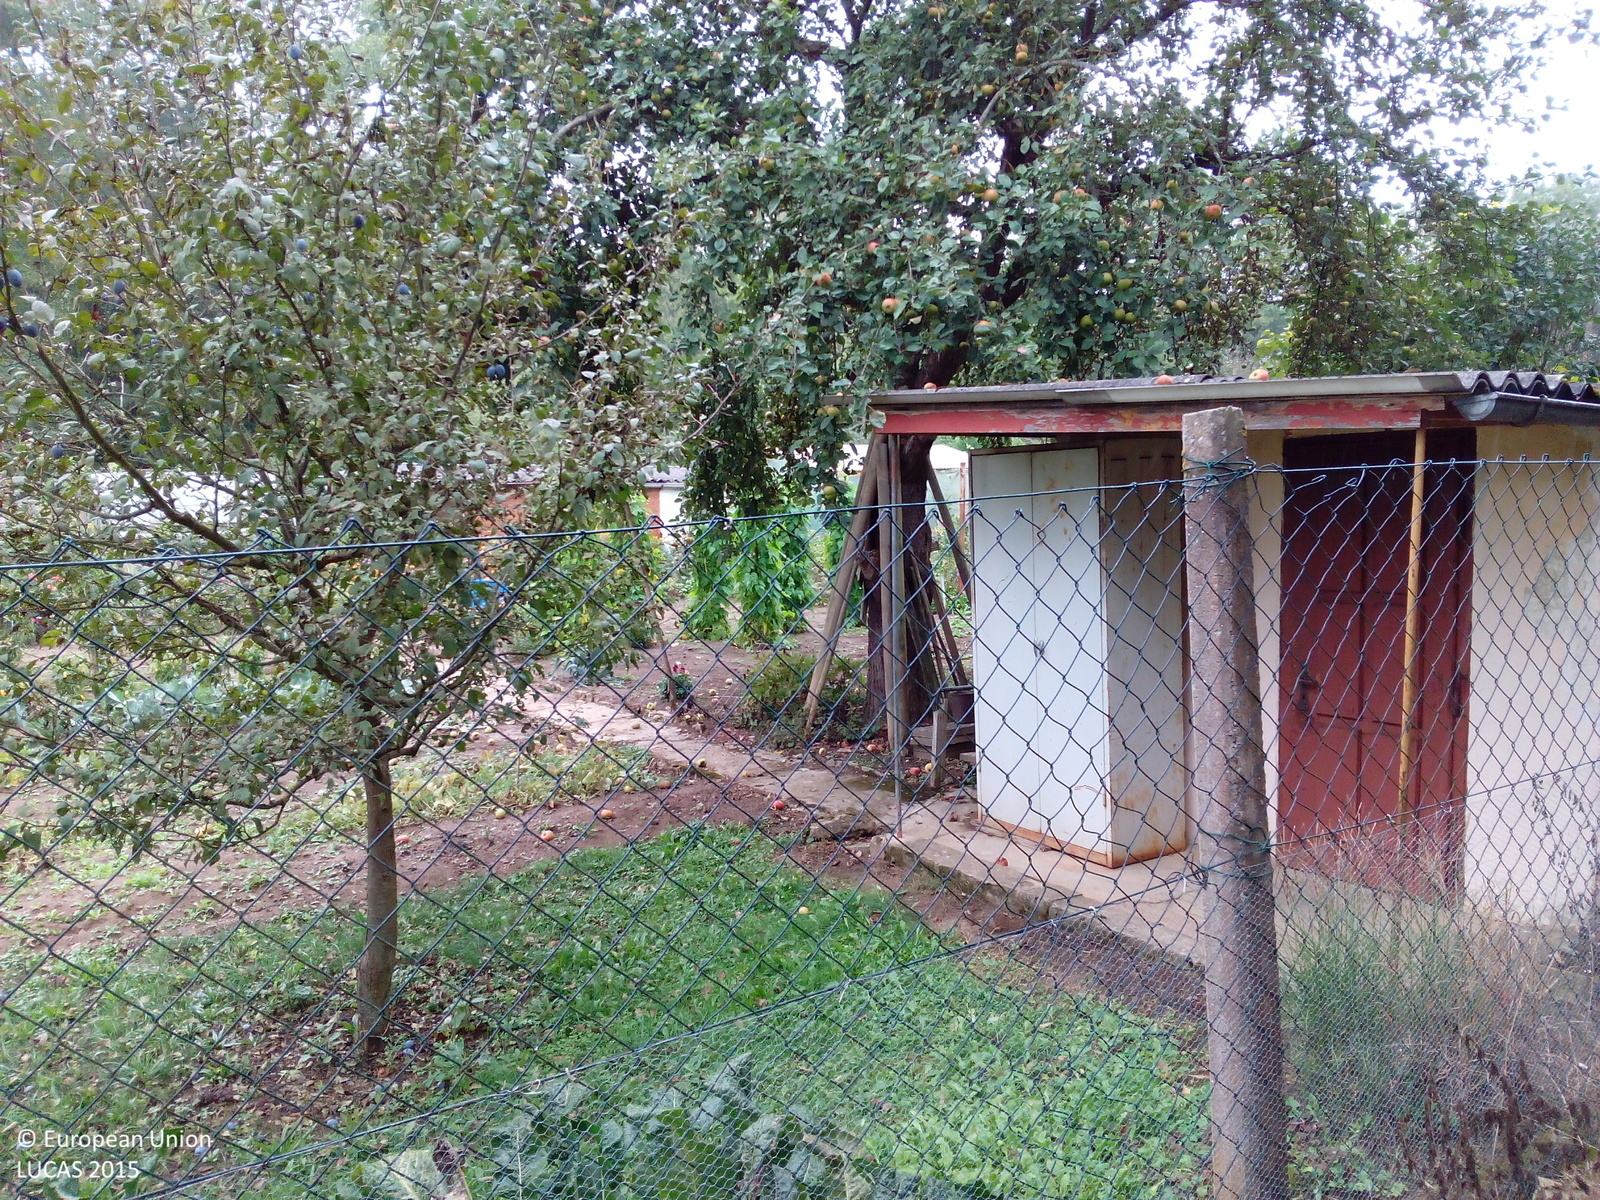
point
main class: Cropland
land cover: Apple fruit
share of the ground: > 75 %
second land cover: Grassland without tree/shrub cover
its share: > 75 %
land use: Kitchen garden
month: September
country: DE
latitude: 49.8425
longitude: 9.9583
